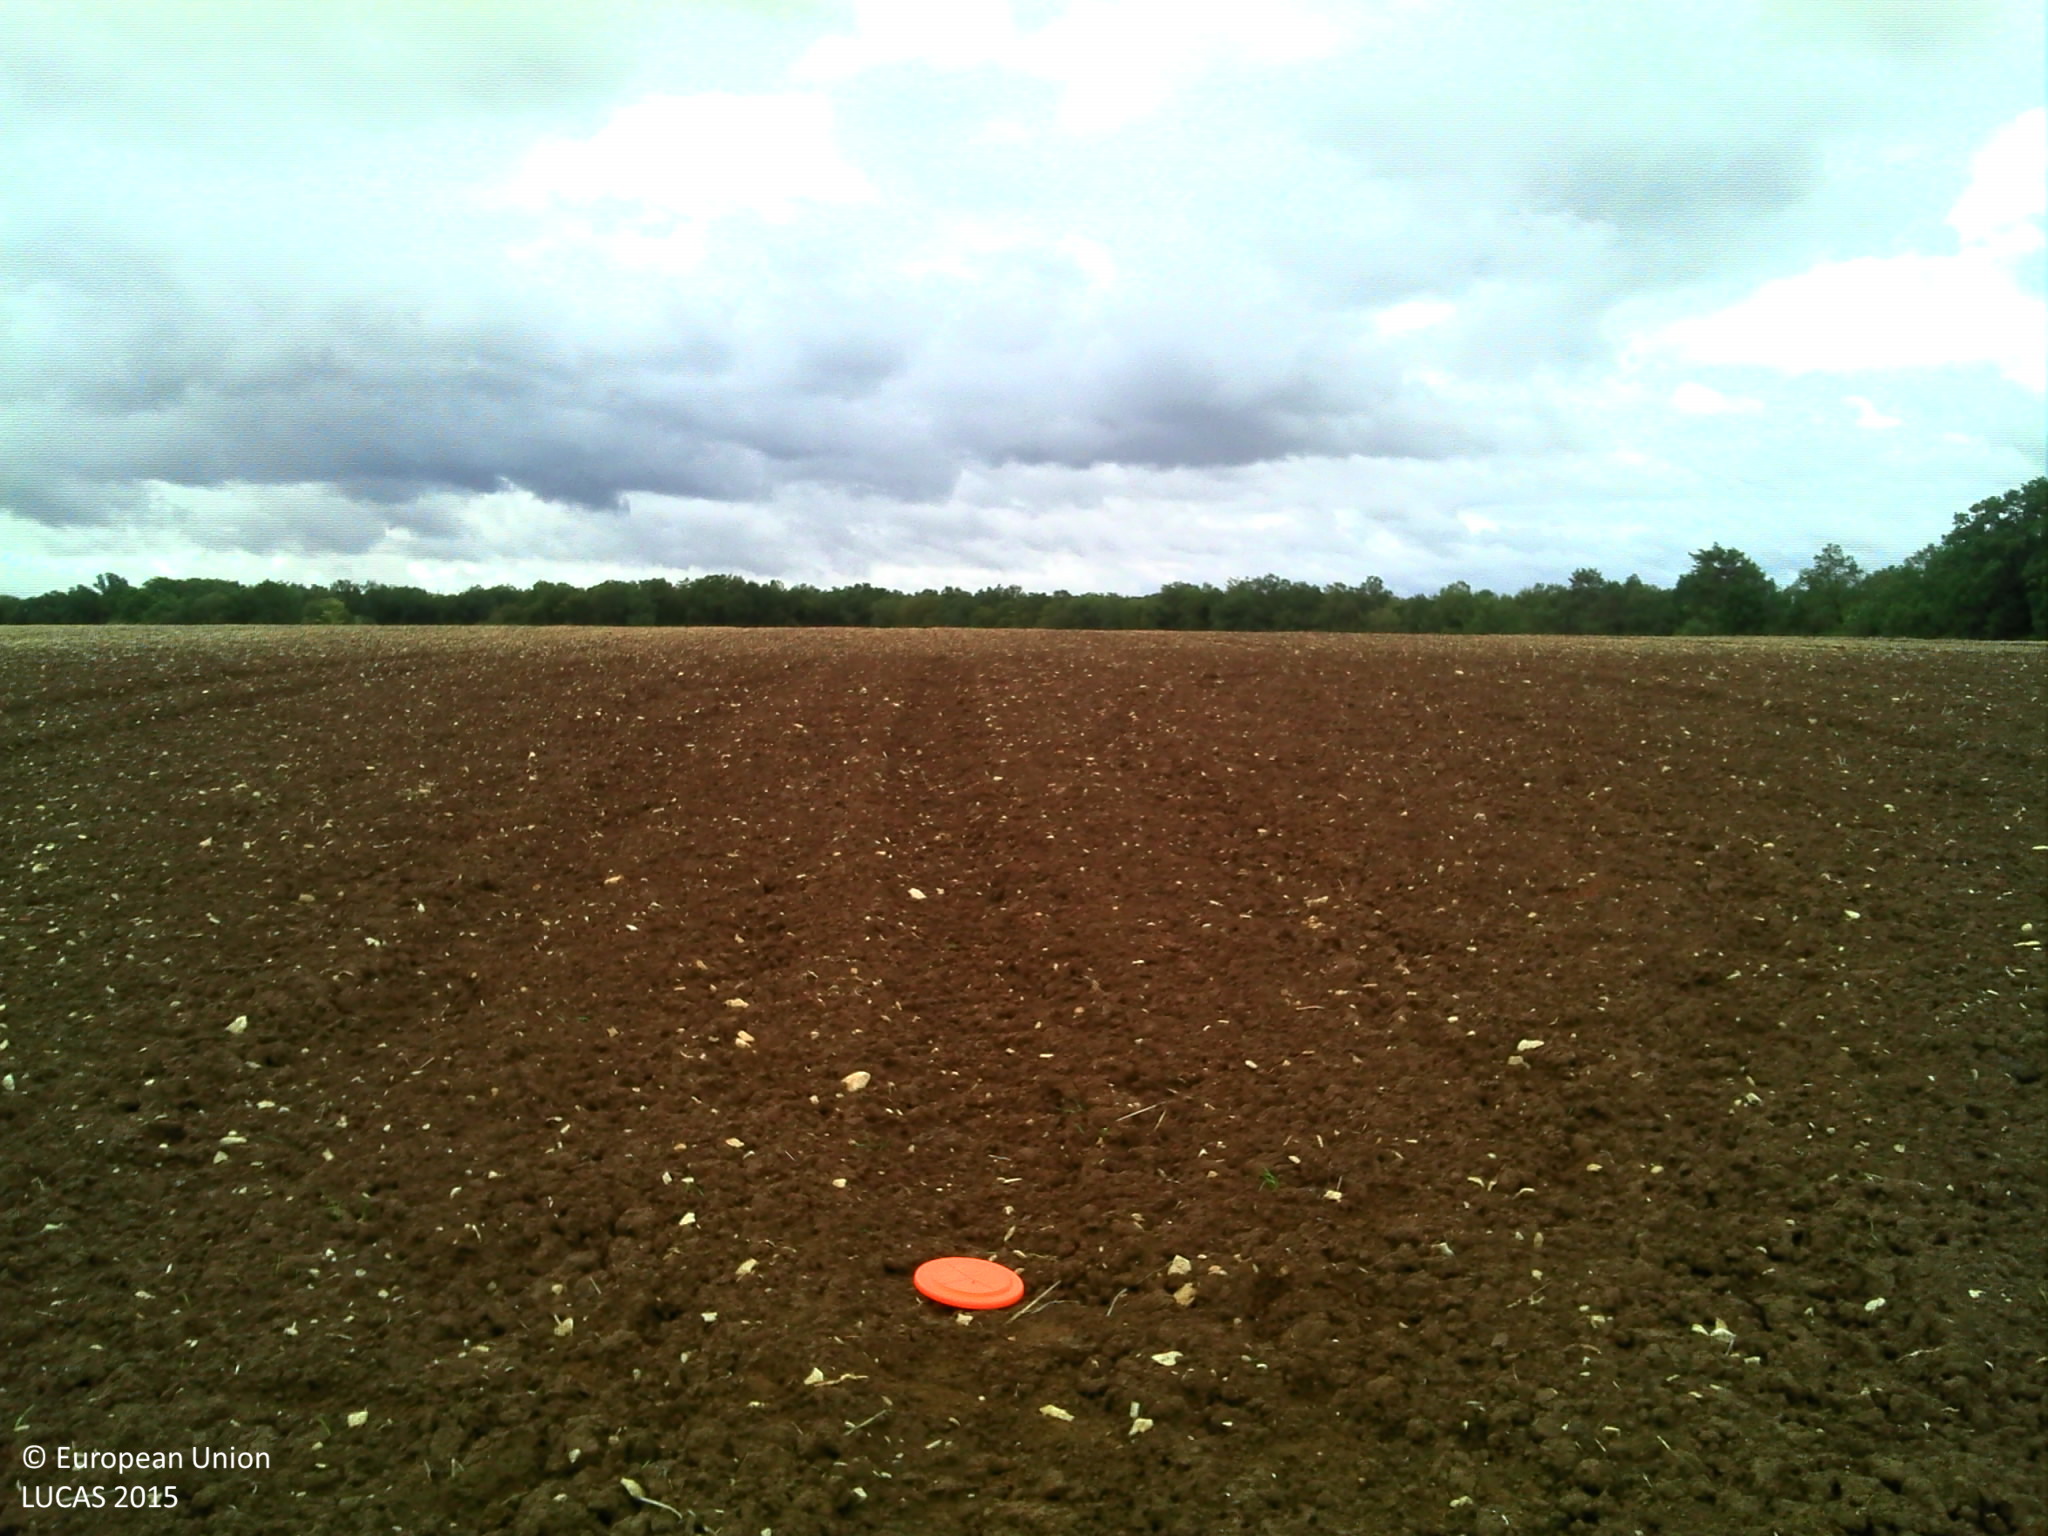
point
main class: Cropland
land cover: Common wheat
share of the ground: < 10 %
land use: Agriculture (excluding fallow land and kitchen gardens)
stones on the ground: < 10 %
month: September
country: FR
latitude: 47.6977
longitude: 4.3084
